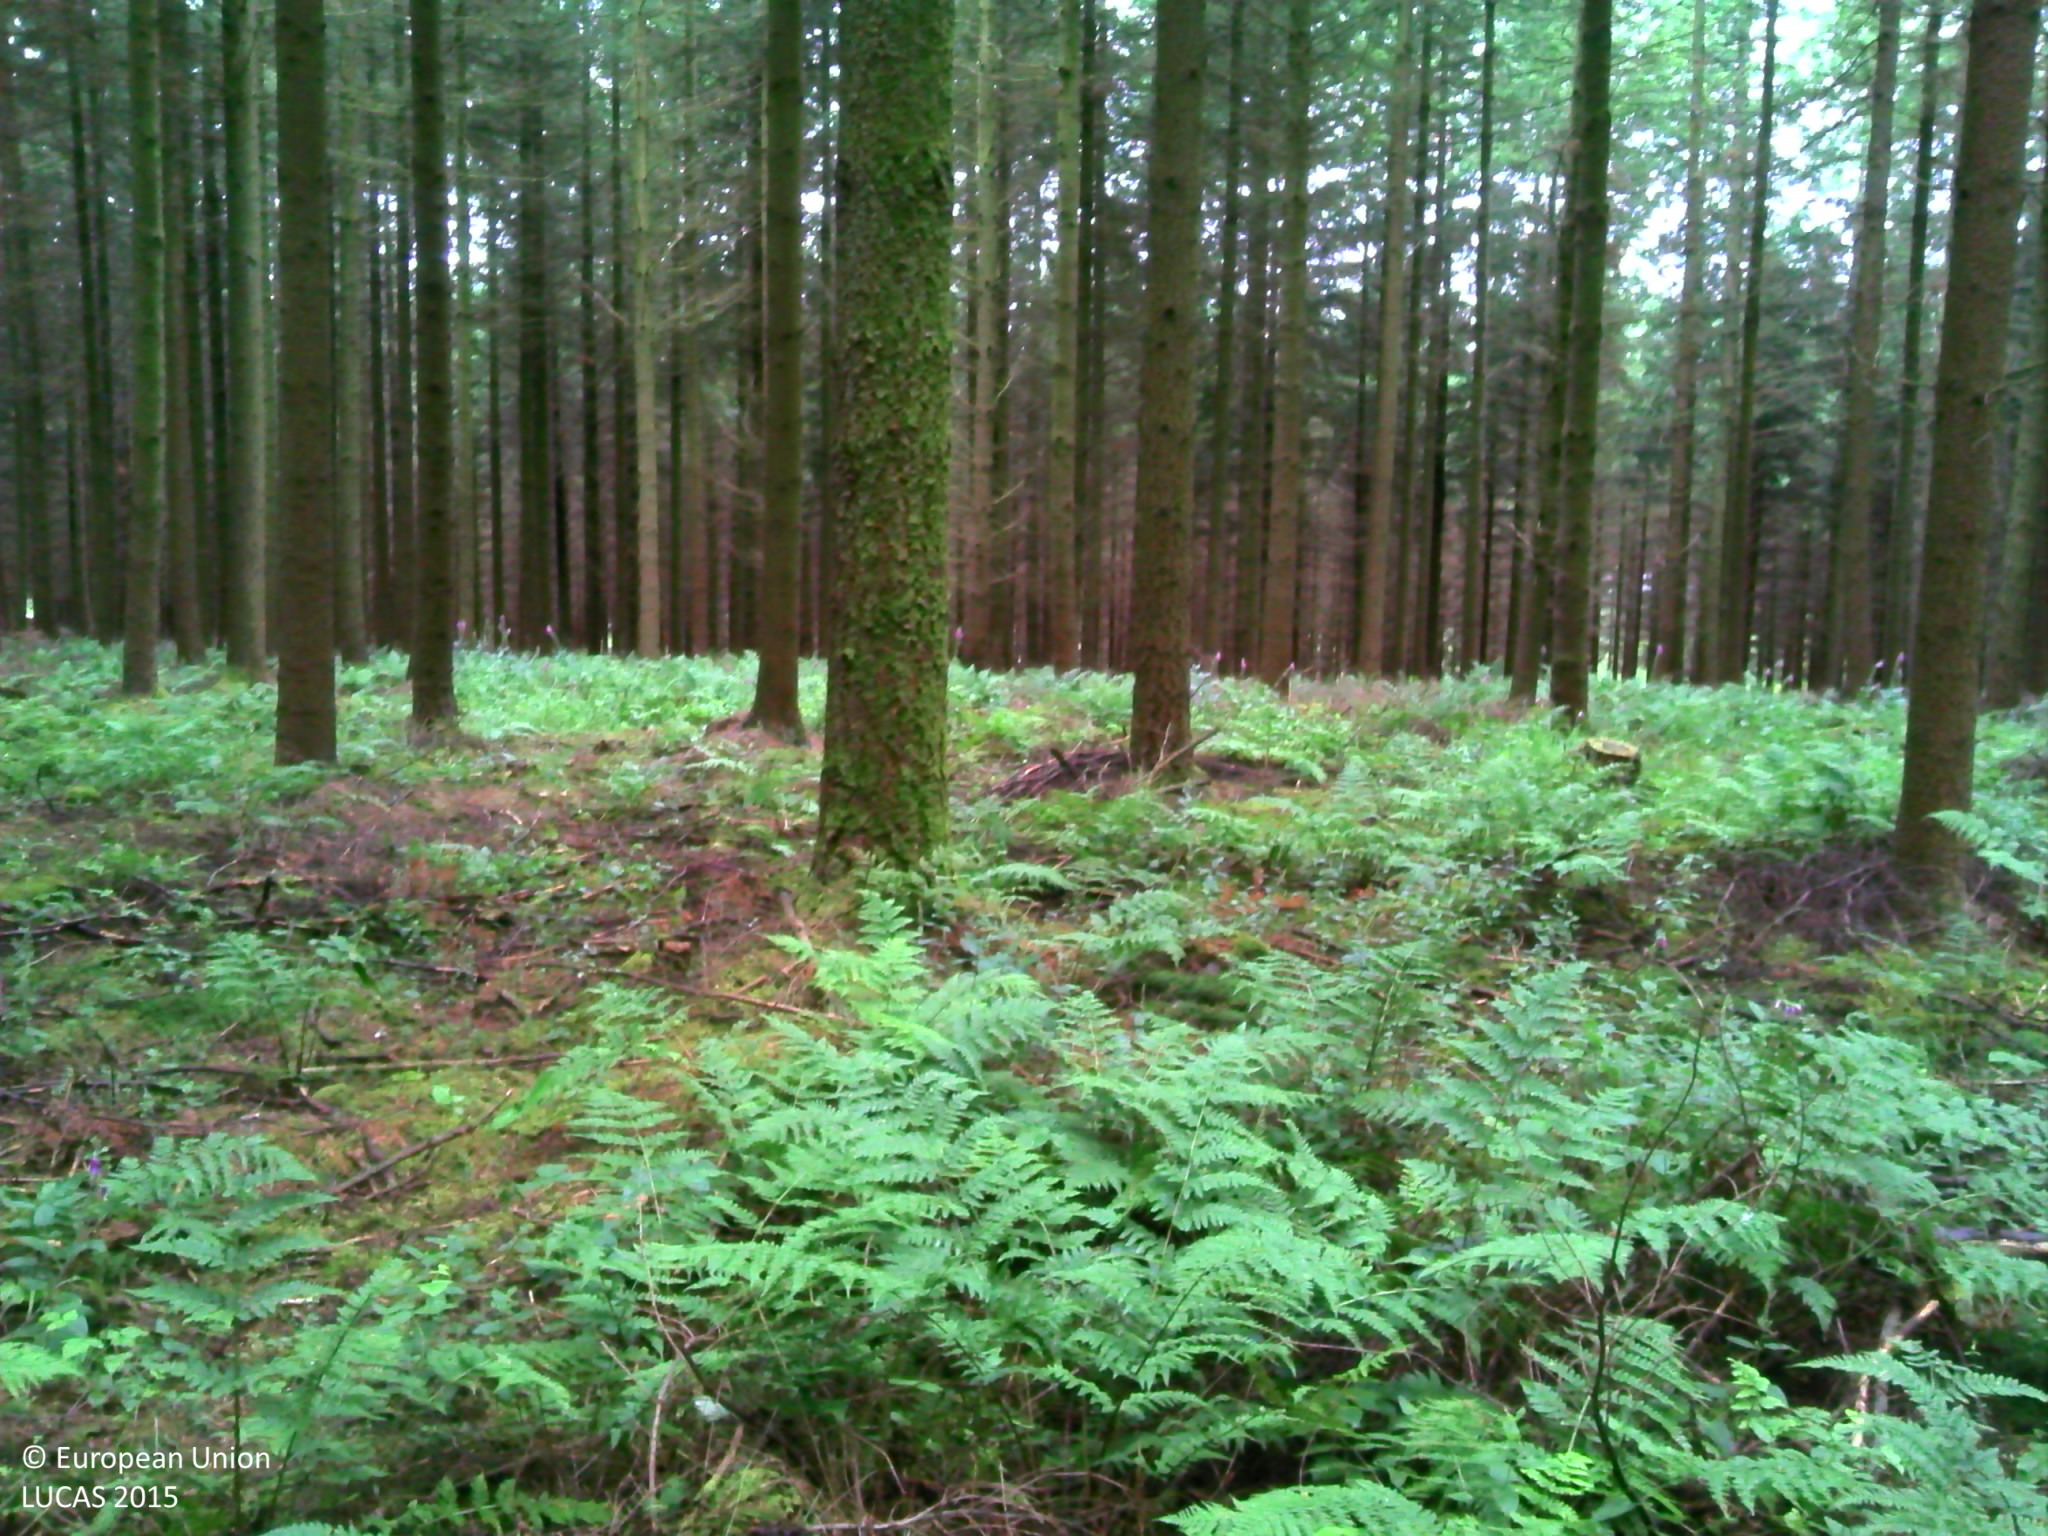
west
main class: Woodland
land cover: Other coniferous woodland
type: exotic forest
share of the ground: > 75 %
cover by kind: coniferous forest trees 95 %, herbaceous plants 5 %
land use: Forestry
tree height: > 5 m
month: July
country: BE
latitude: 50.1235
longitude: 5.7606
